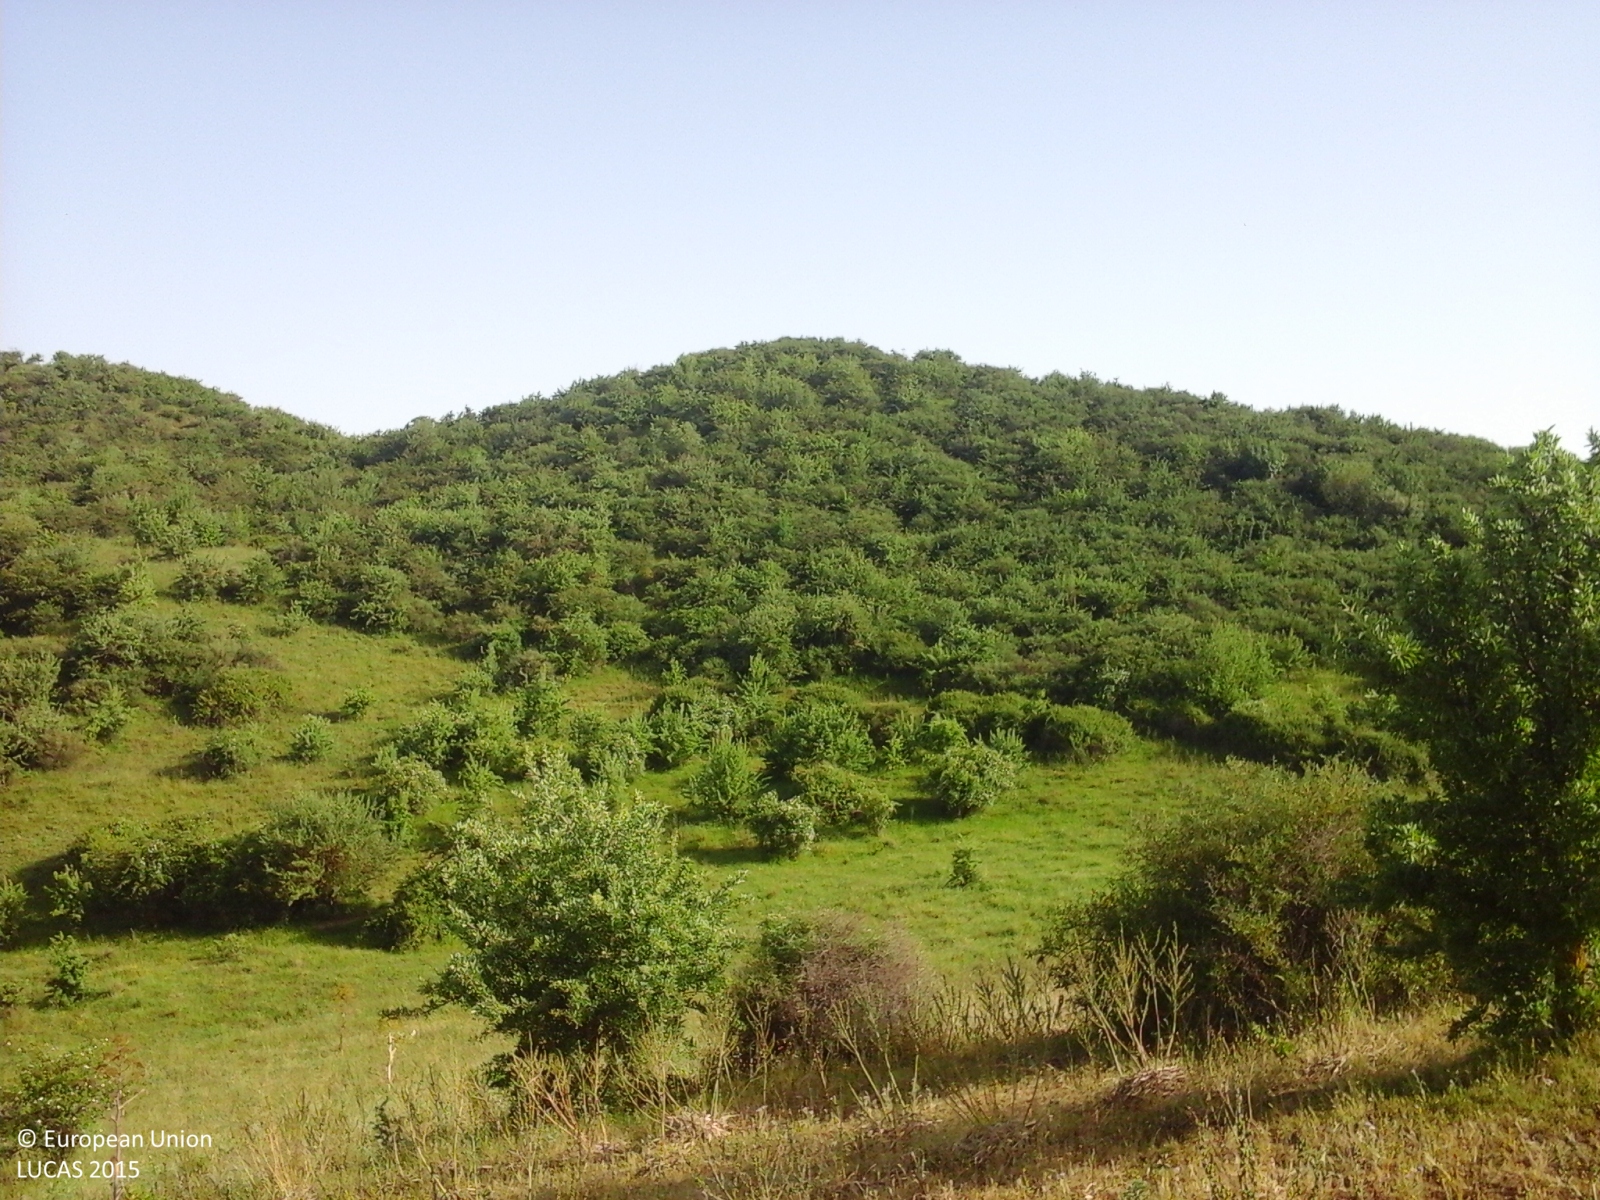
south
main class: Grassland
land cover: Grassland with sparse tree/shrub cover
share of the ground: > 75 %
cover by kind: herbaceous plants 90 %, broadleaved forest trees 5 %, shrubs 5 %
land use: Agriculture (excluding fallow land and kitchen gardens)
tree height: < 5 m
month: May
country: IT
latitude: 37.6979
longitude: 14.0422
